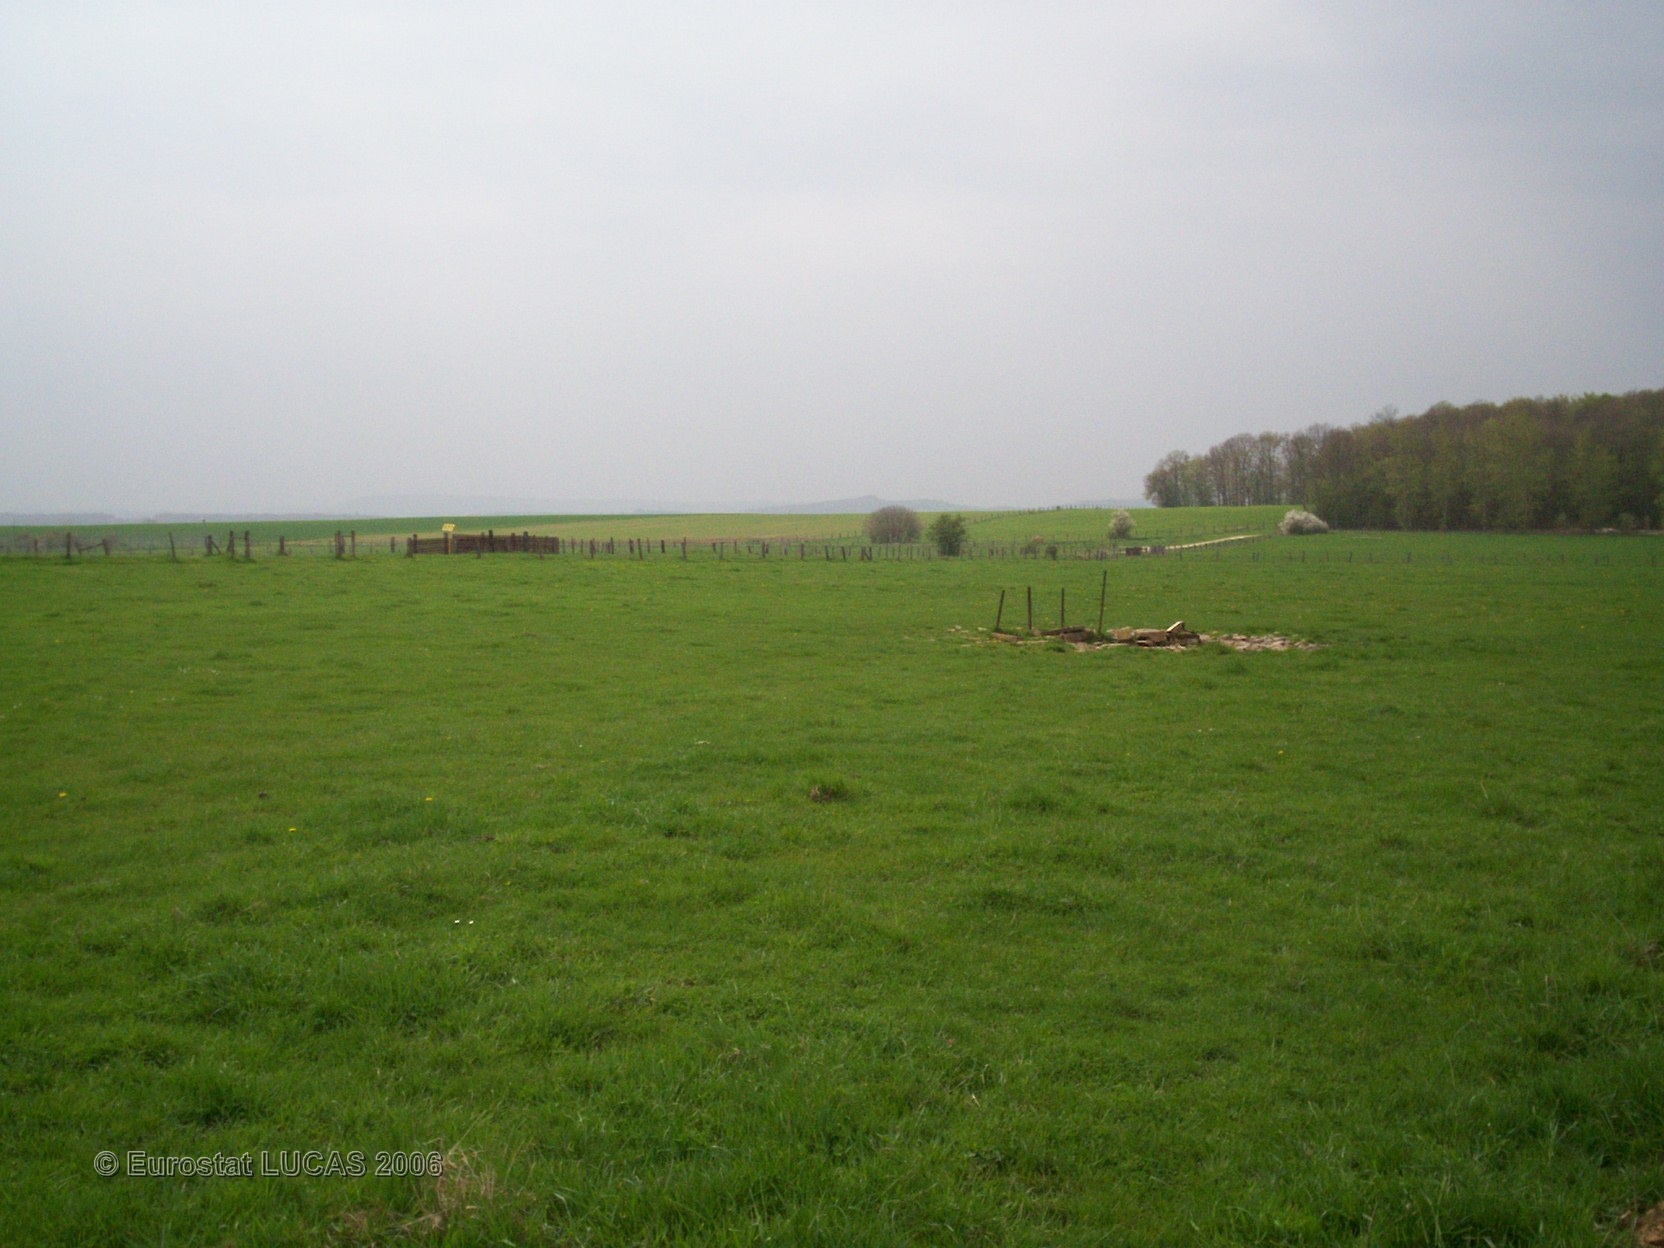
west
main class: Grassland
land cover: Grassland without tree/shrub cover
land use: Agriculture (excluding fallow land and kitchen gardens)
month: April
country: FR
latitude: 48.3290
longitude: 5.9401
